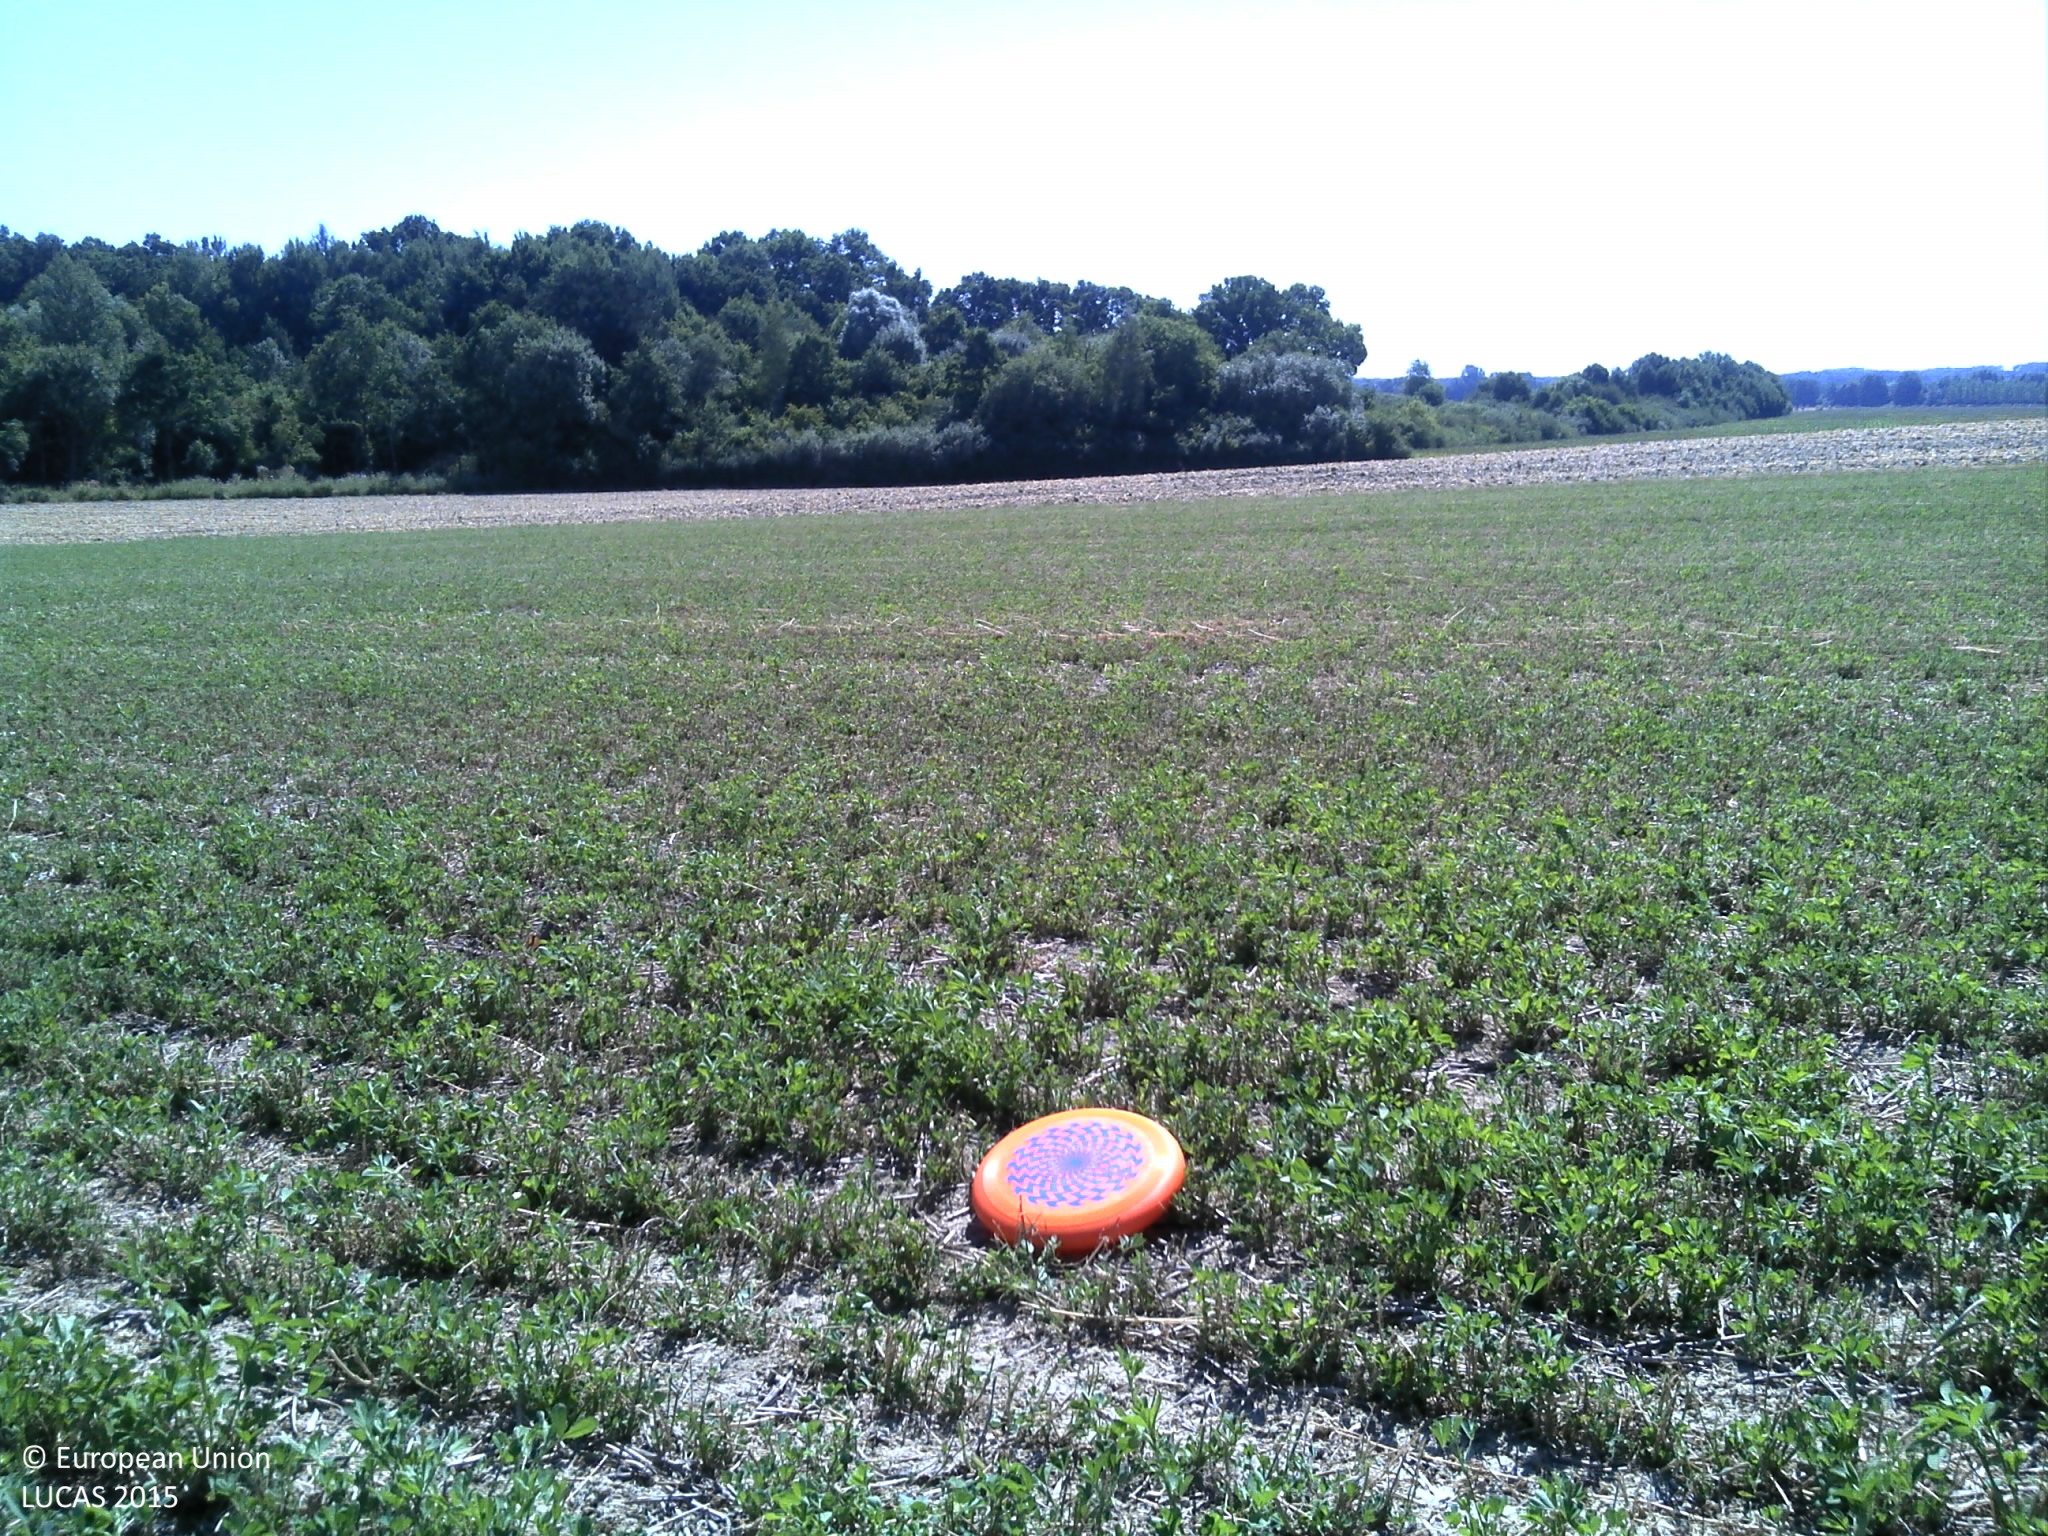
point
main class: Cropland
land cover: Lucerne
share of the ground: > 75 %
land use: Agriculture (excluding fallow land and kitchen gardens)
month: August
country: FR
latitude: 49.2004
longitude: 4.7958
